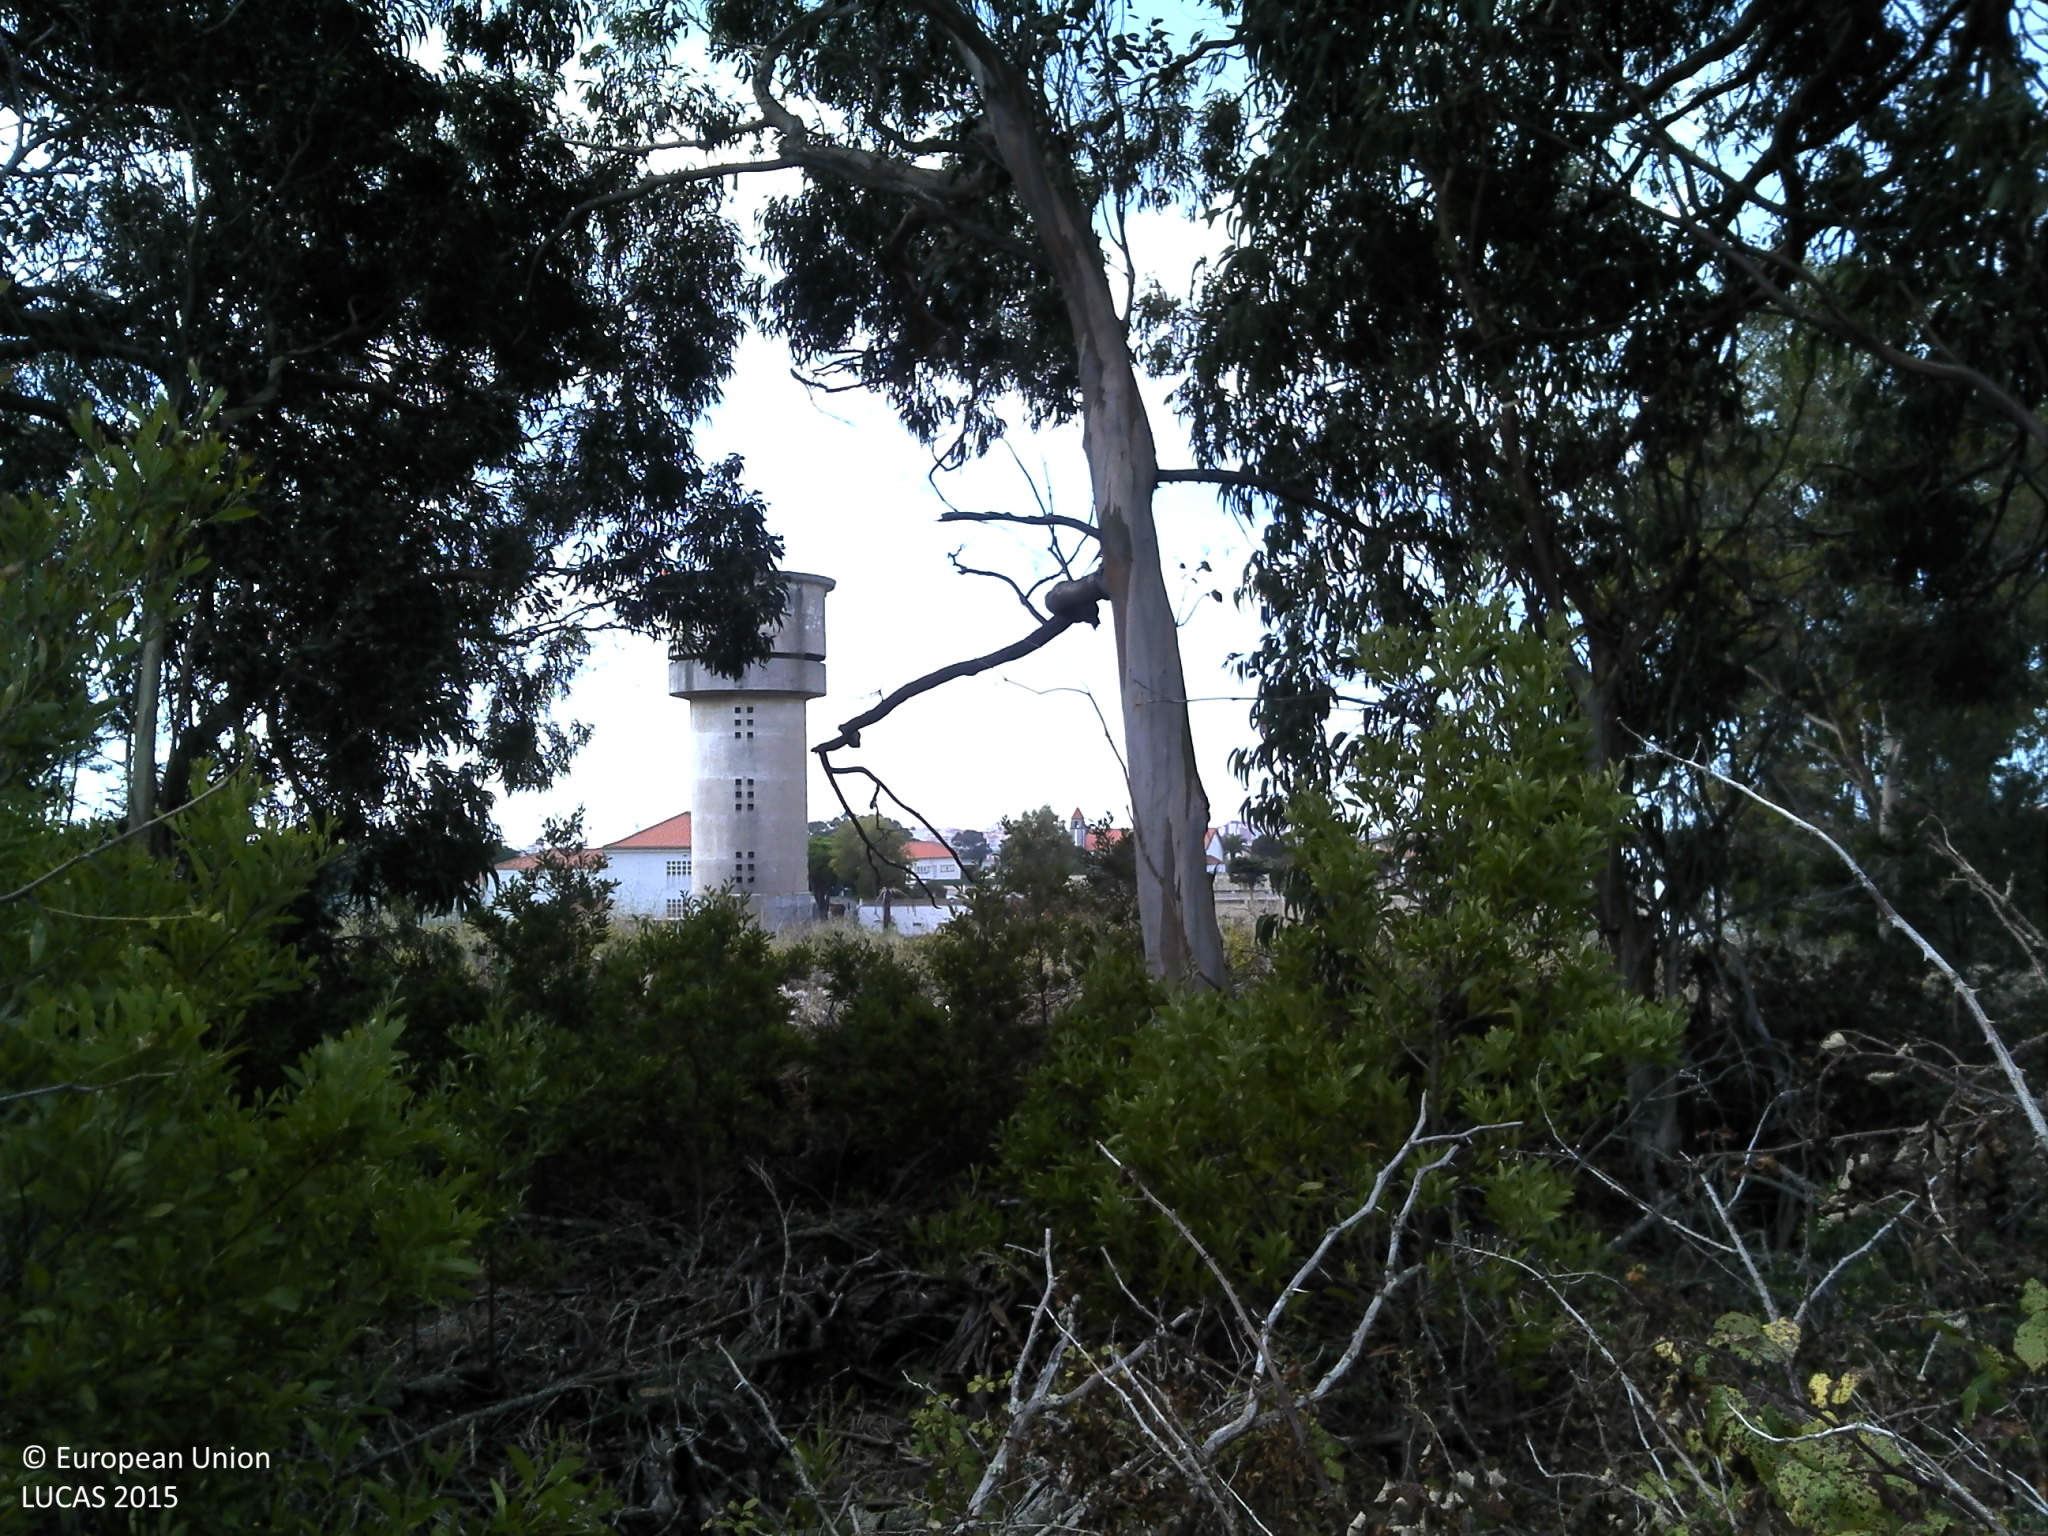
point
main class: Woodland
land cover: Broadleaved woodland
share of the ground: 25 - 50 %
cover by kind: broadleaved forest trees 50 %, unconsolidated bare surface 30 %, shrubs 10 %, herbaceous plants 10 %
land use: Community services
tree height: > 5 m
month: September
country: PT
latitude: 38.7283
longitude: -9.3487
